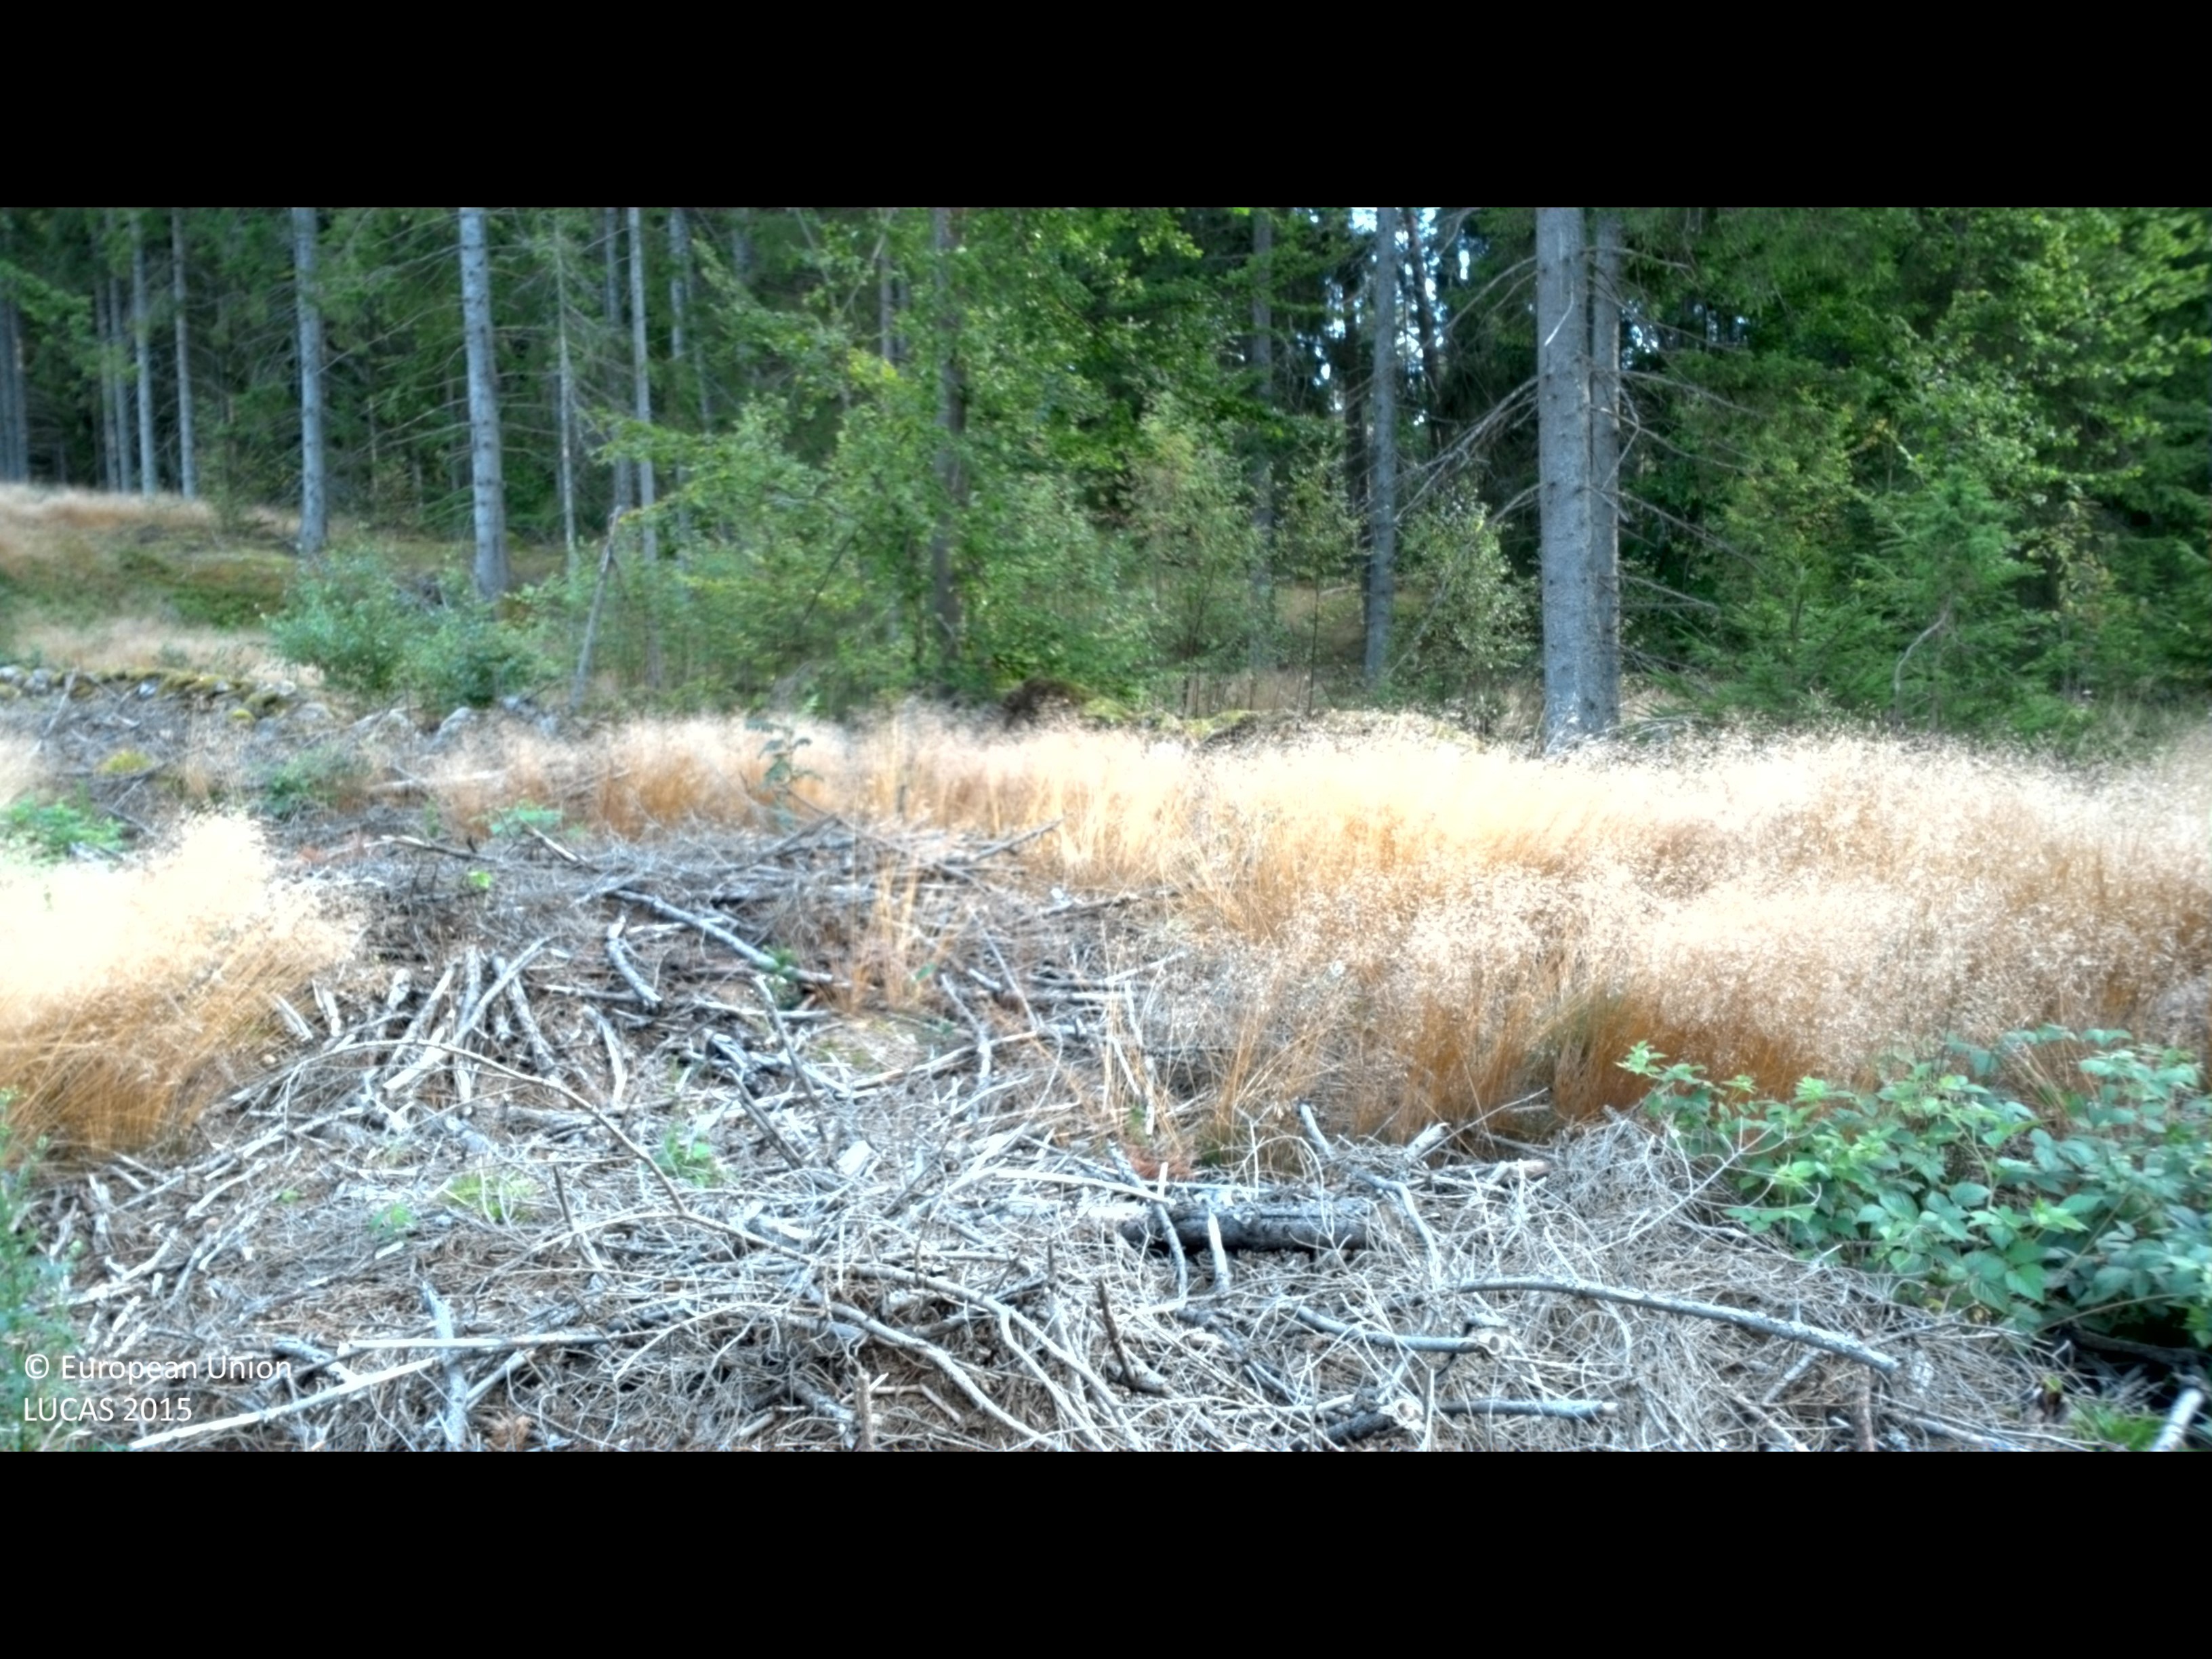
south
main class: Grassland
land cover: Spontaneously vegetated surfaces
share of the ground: > 75 %
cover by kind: herbaceous plants 90 %, shrubs 5 %
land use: Forestry
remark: Clear cut
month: August
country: SE
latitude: 56.3145
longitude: 15.2530
